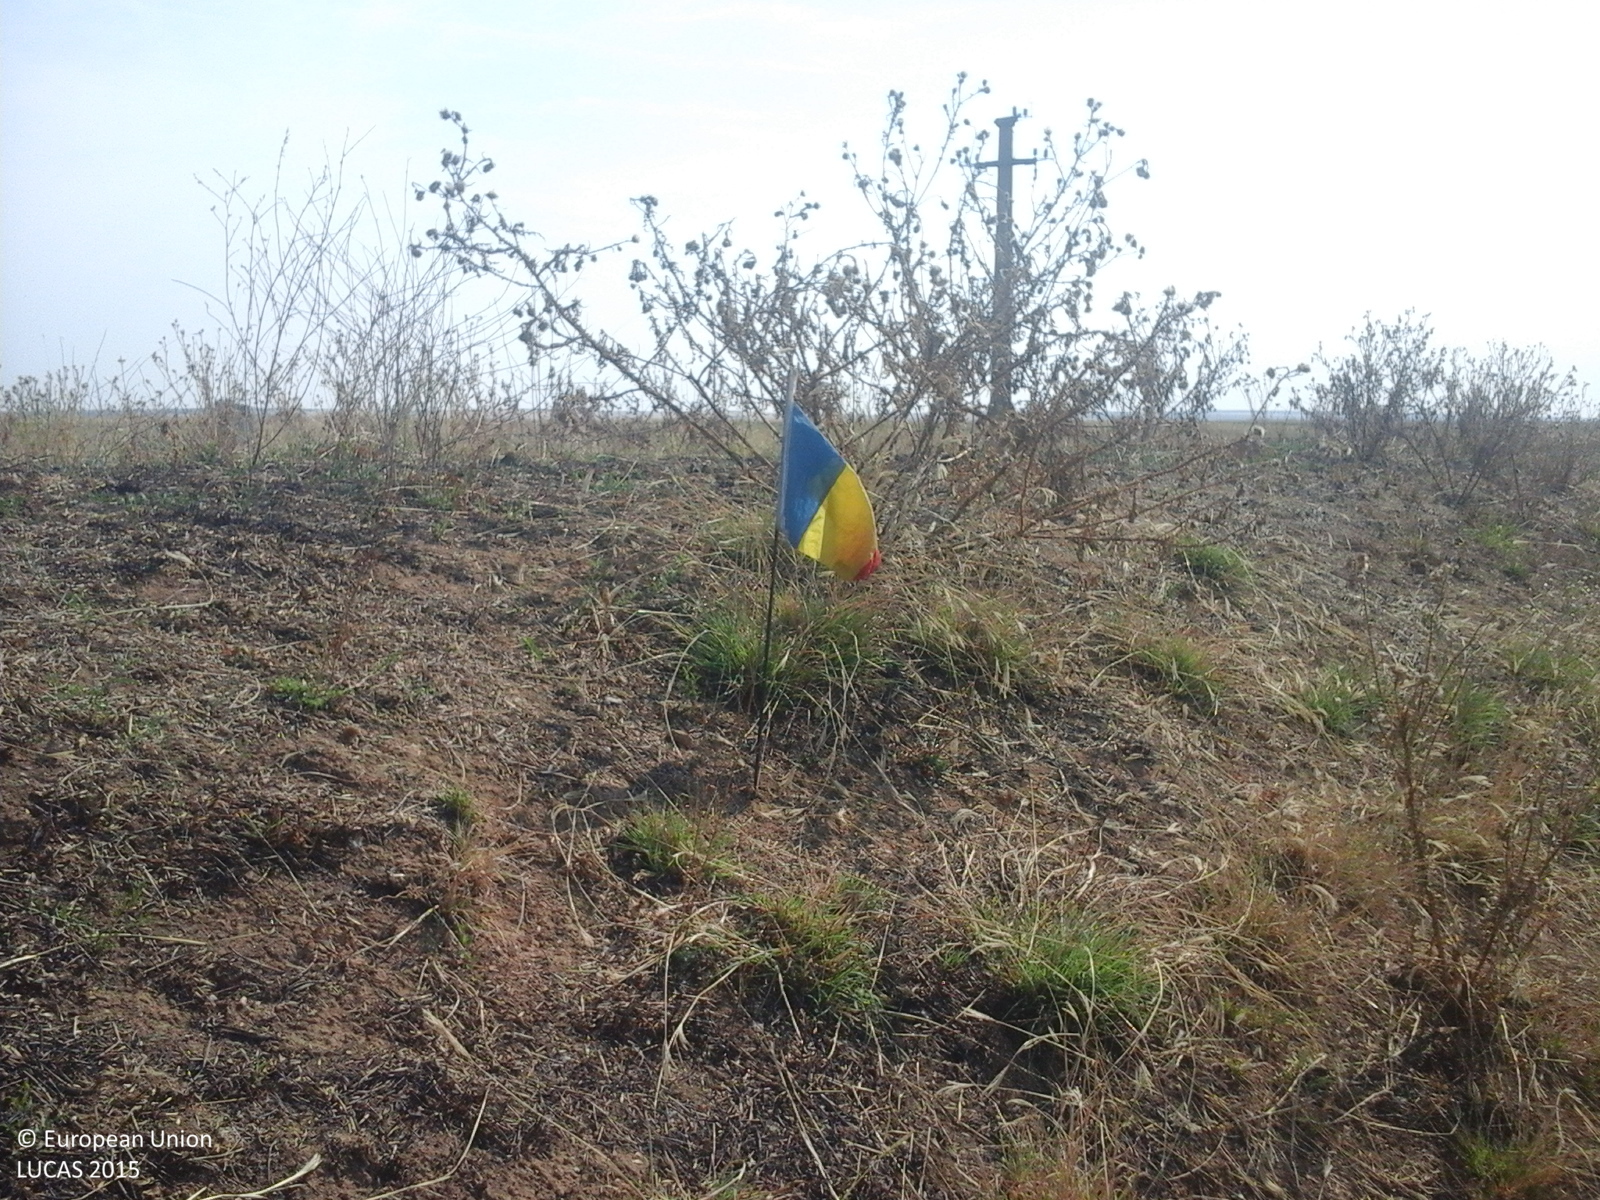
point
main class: Grassland
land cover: Spontaneously vegetated surfaces
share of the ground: > 75 %
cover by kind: herbaceous plants 100 %
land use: Fallow land
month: August
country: RO
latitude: 44.2548
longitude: 23.0320
